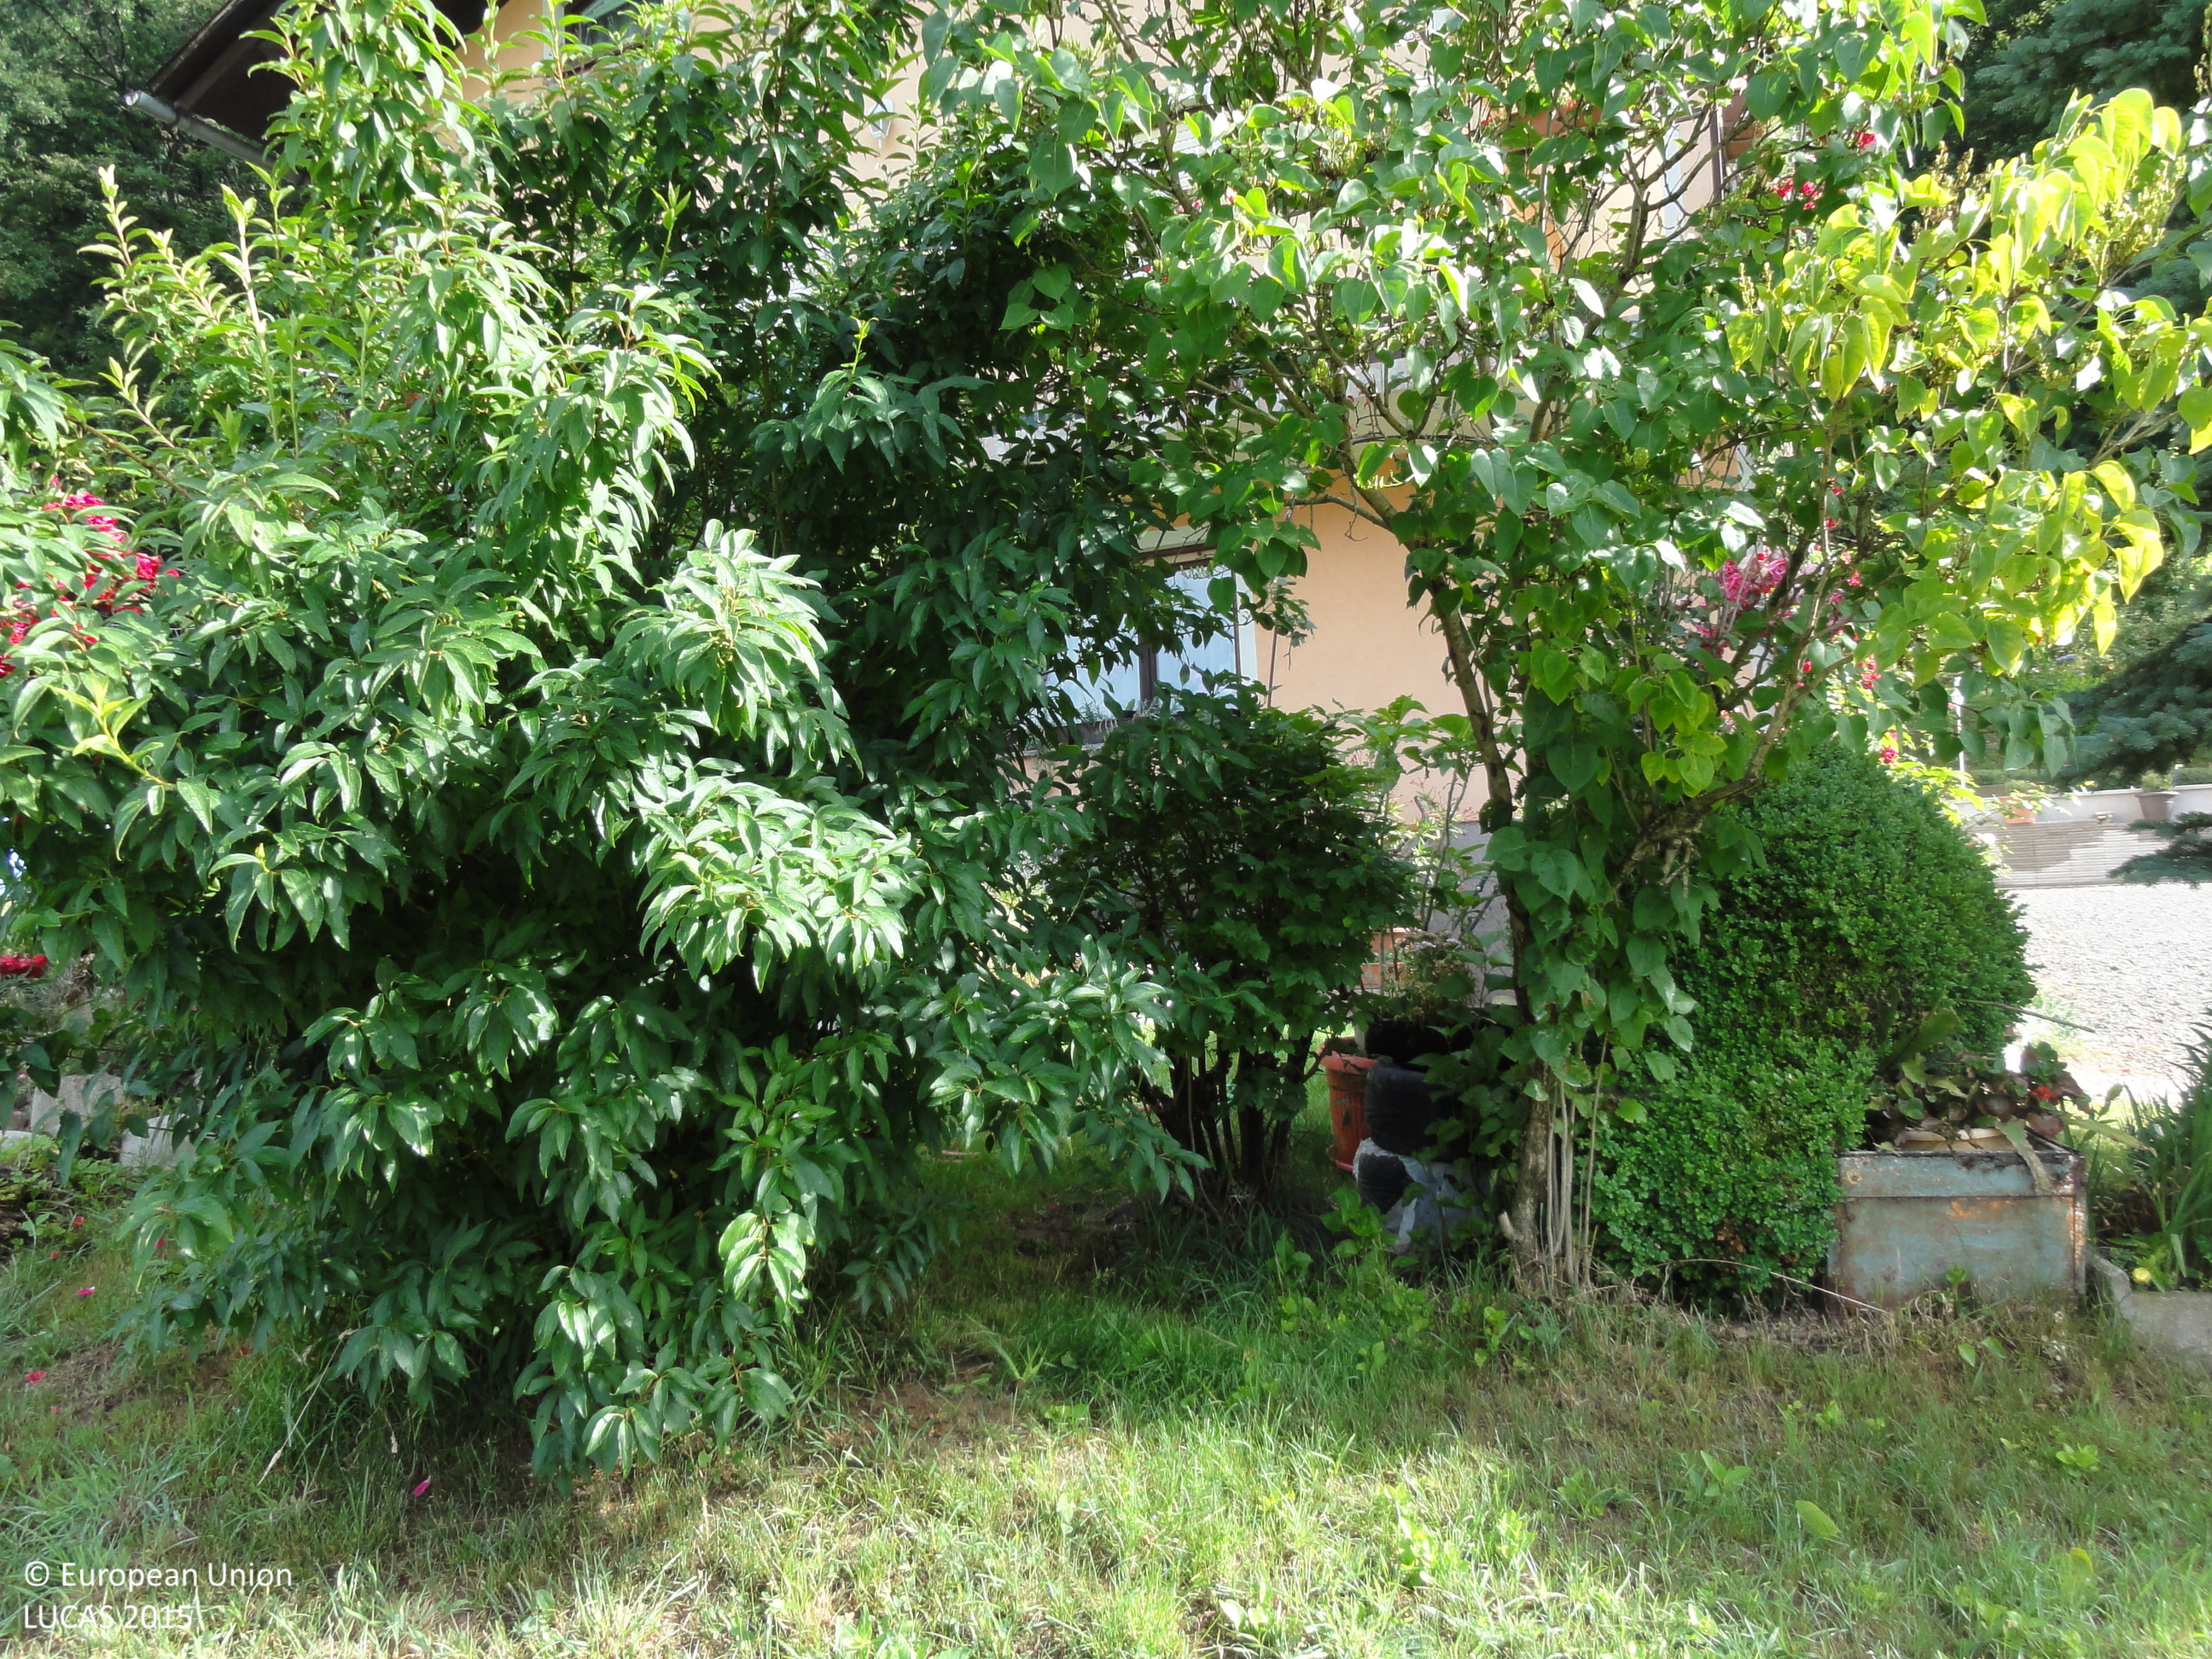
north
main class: Grassland
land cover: Grassland without tree/shrub cover
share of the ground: > 75 %
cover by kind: herbaceous plants 100 %
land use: Agriculture (excluding fallow land and kitchen gardens)
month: June
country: SI
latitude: 46.2675
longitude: 15.7726
